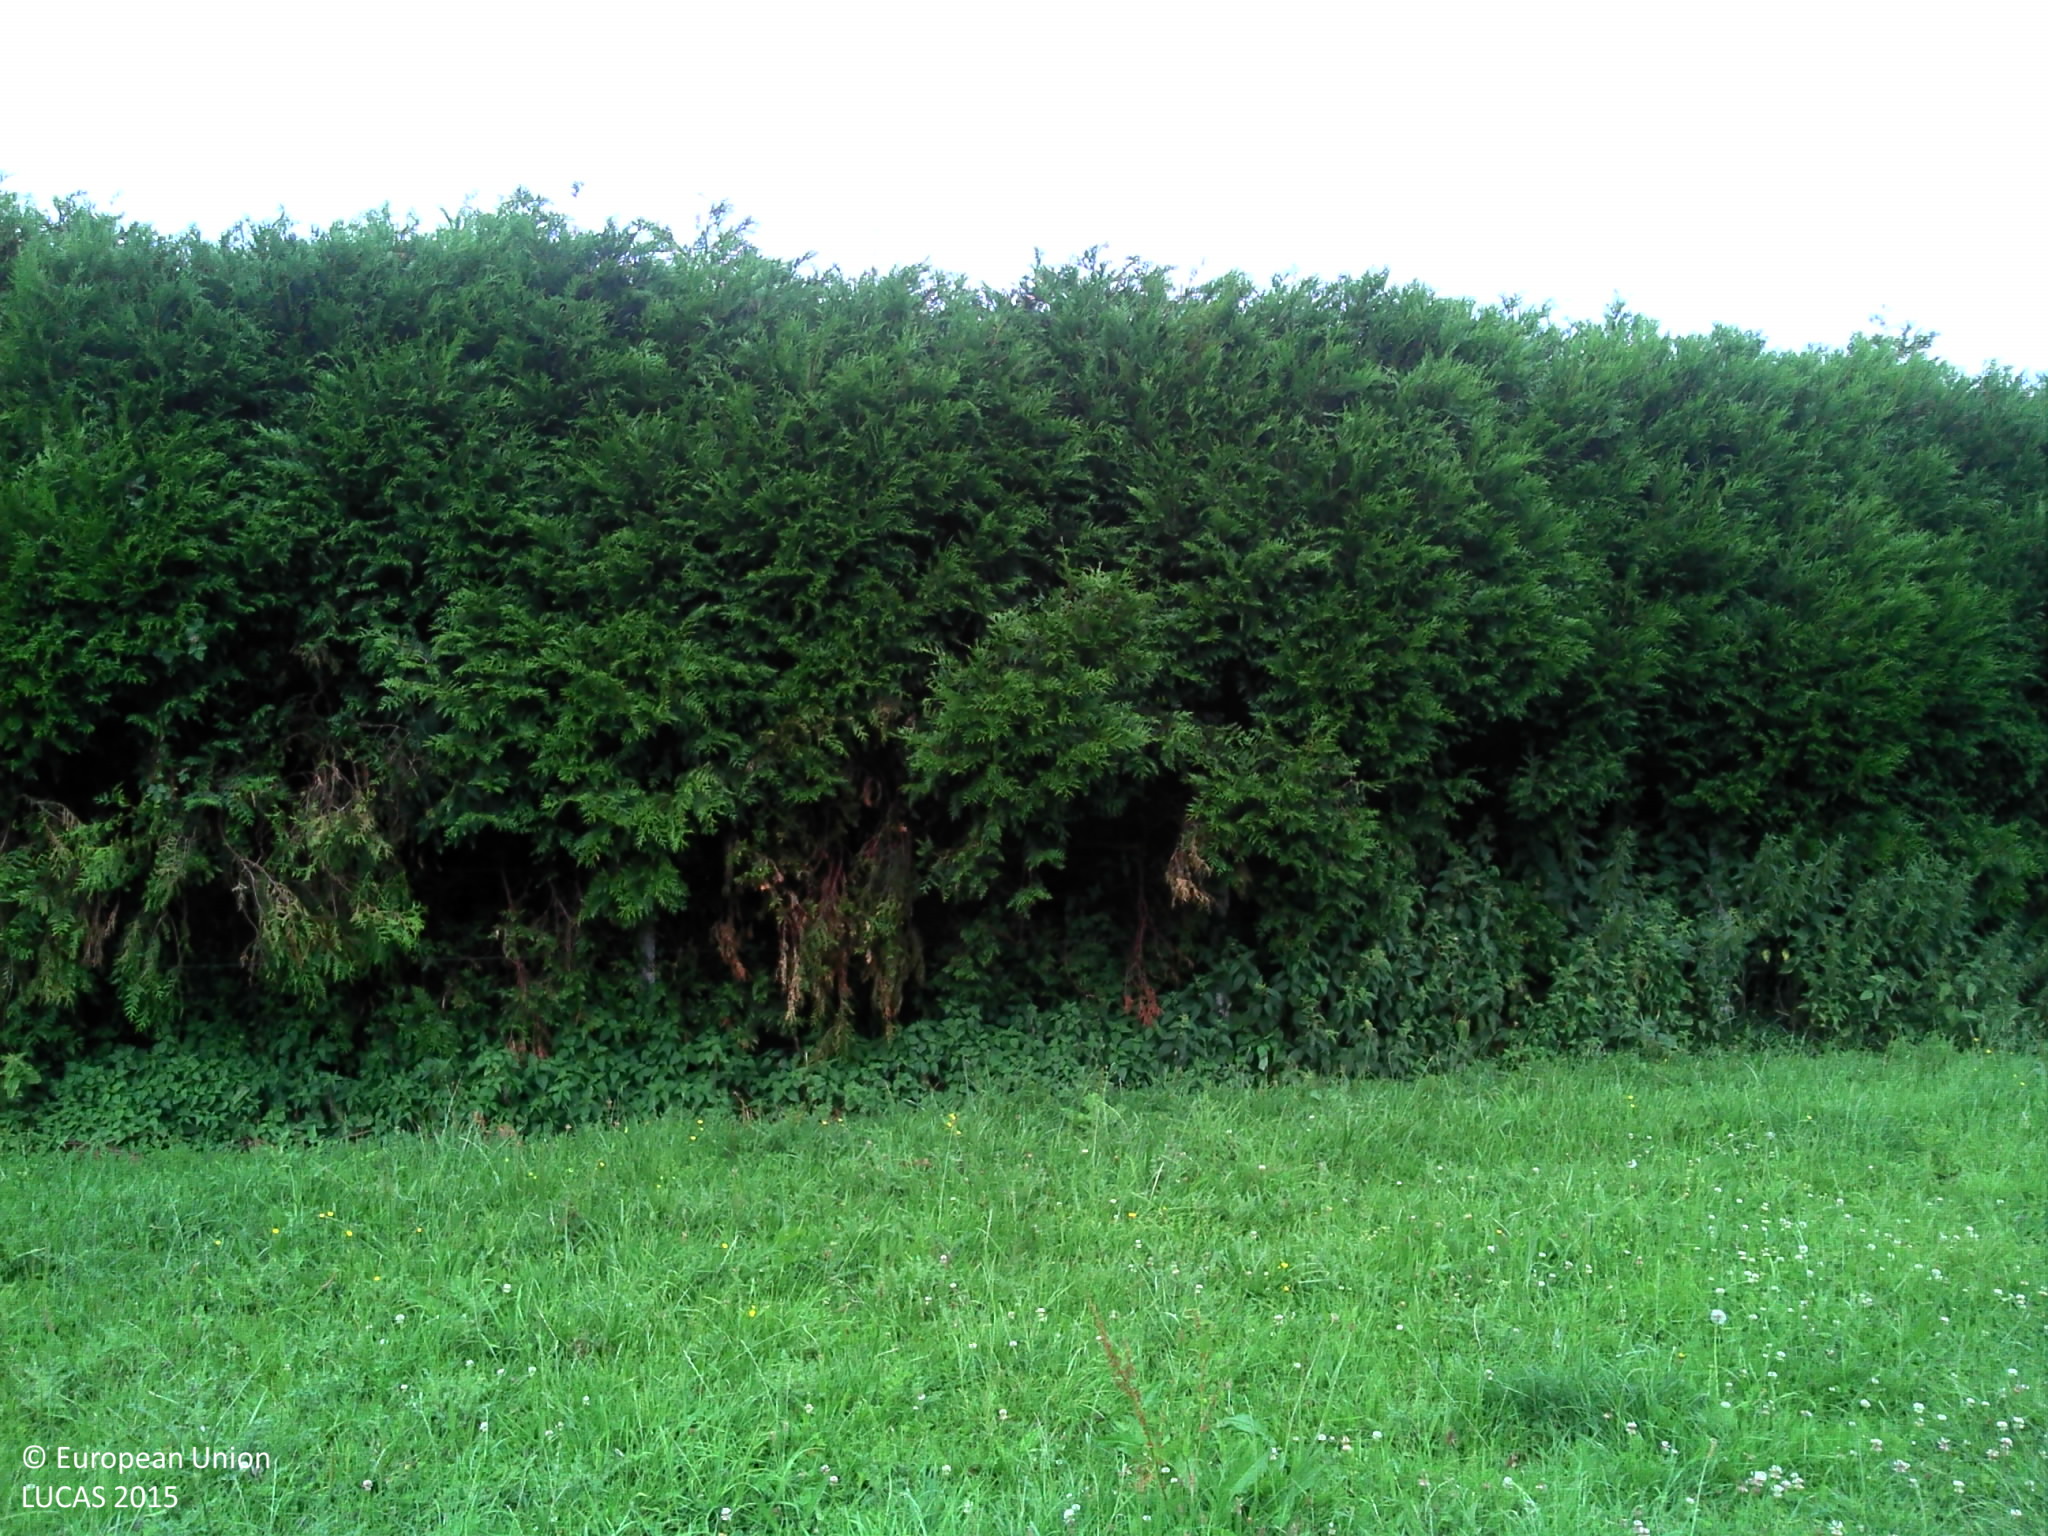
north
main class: Grassland
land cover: Grassland without tree/shrub cover
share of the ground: > 75 %
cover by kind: herbaceous plants 100 %
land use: Agriculture (excluding fallow land and kitchen gardens)
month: July
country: FR
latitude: 49.3727
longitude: 0.3175
